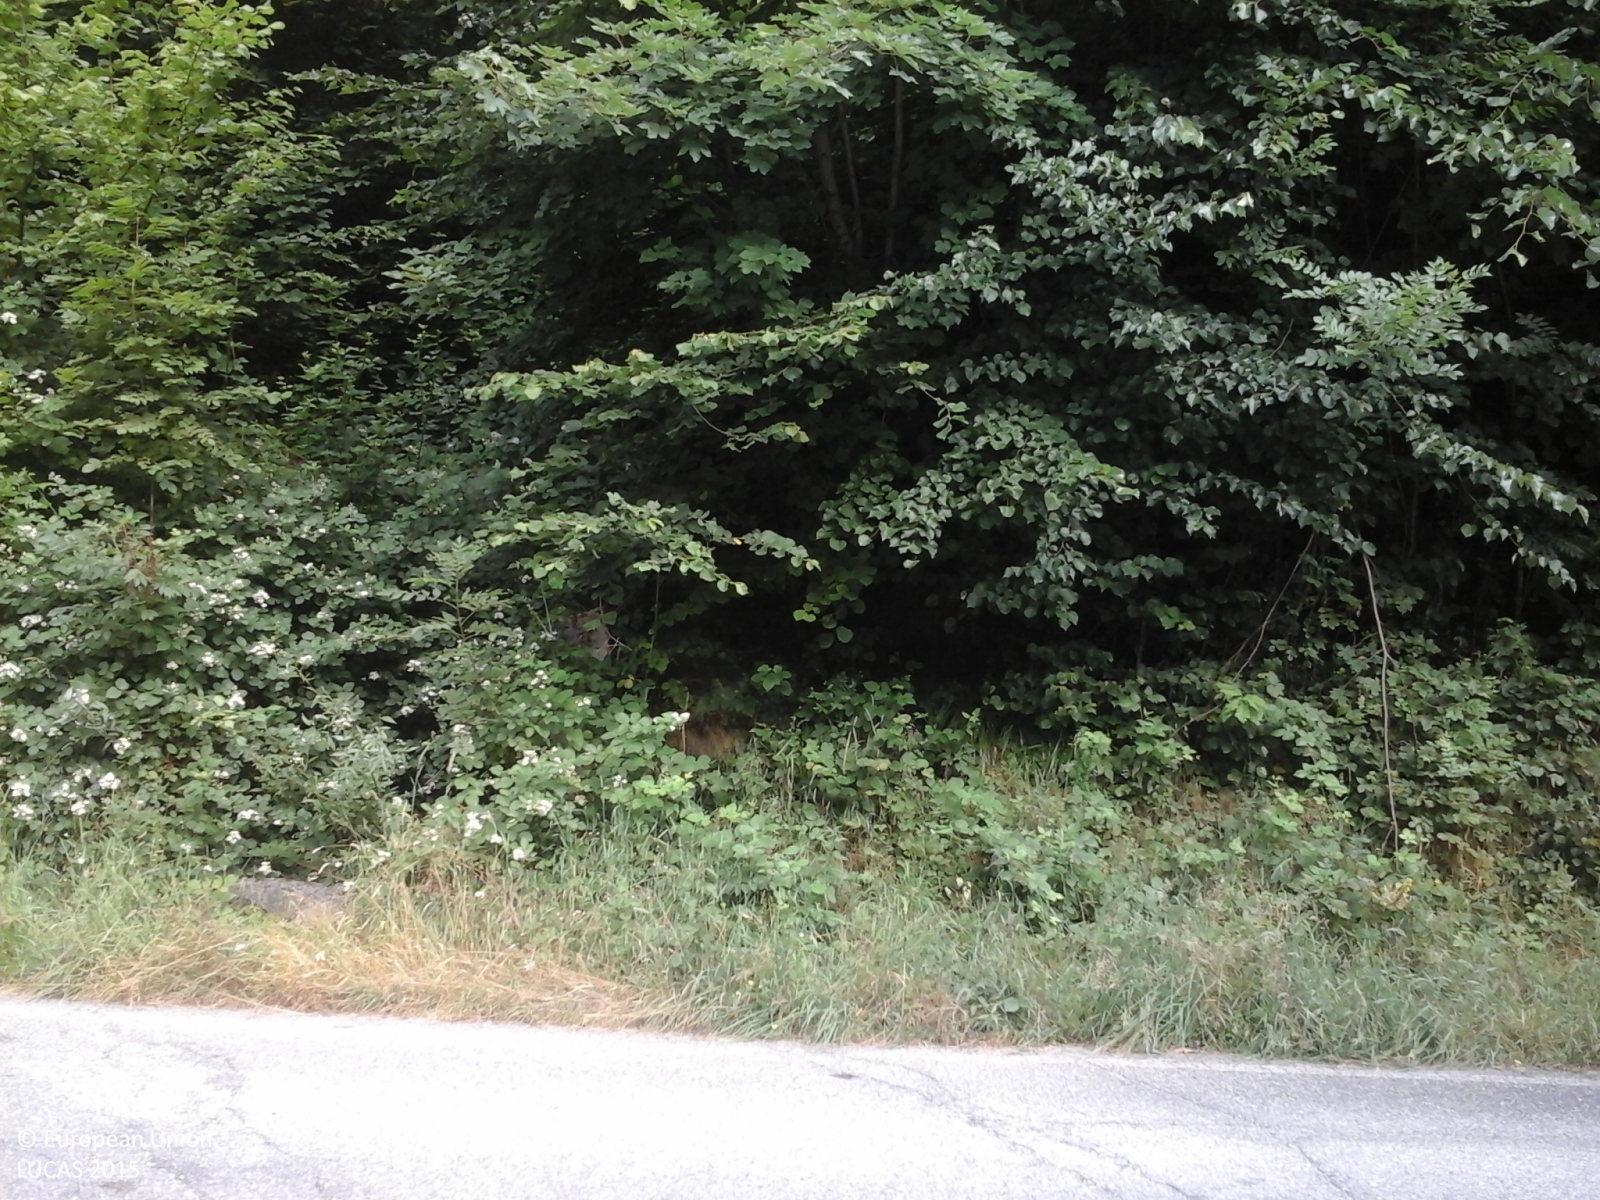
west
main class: Woodland
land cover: Broadleaved woodland
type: mesophytic deciduous forest
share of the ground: > 75 %
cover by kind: broadleaved forest trees 100 %
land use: Forestry
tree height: > 5 m
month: July
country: IT
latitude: 45.0358
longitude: 7.2501
